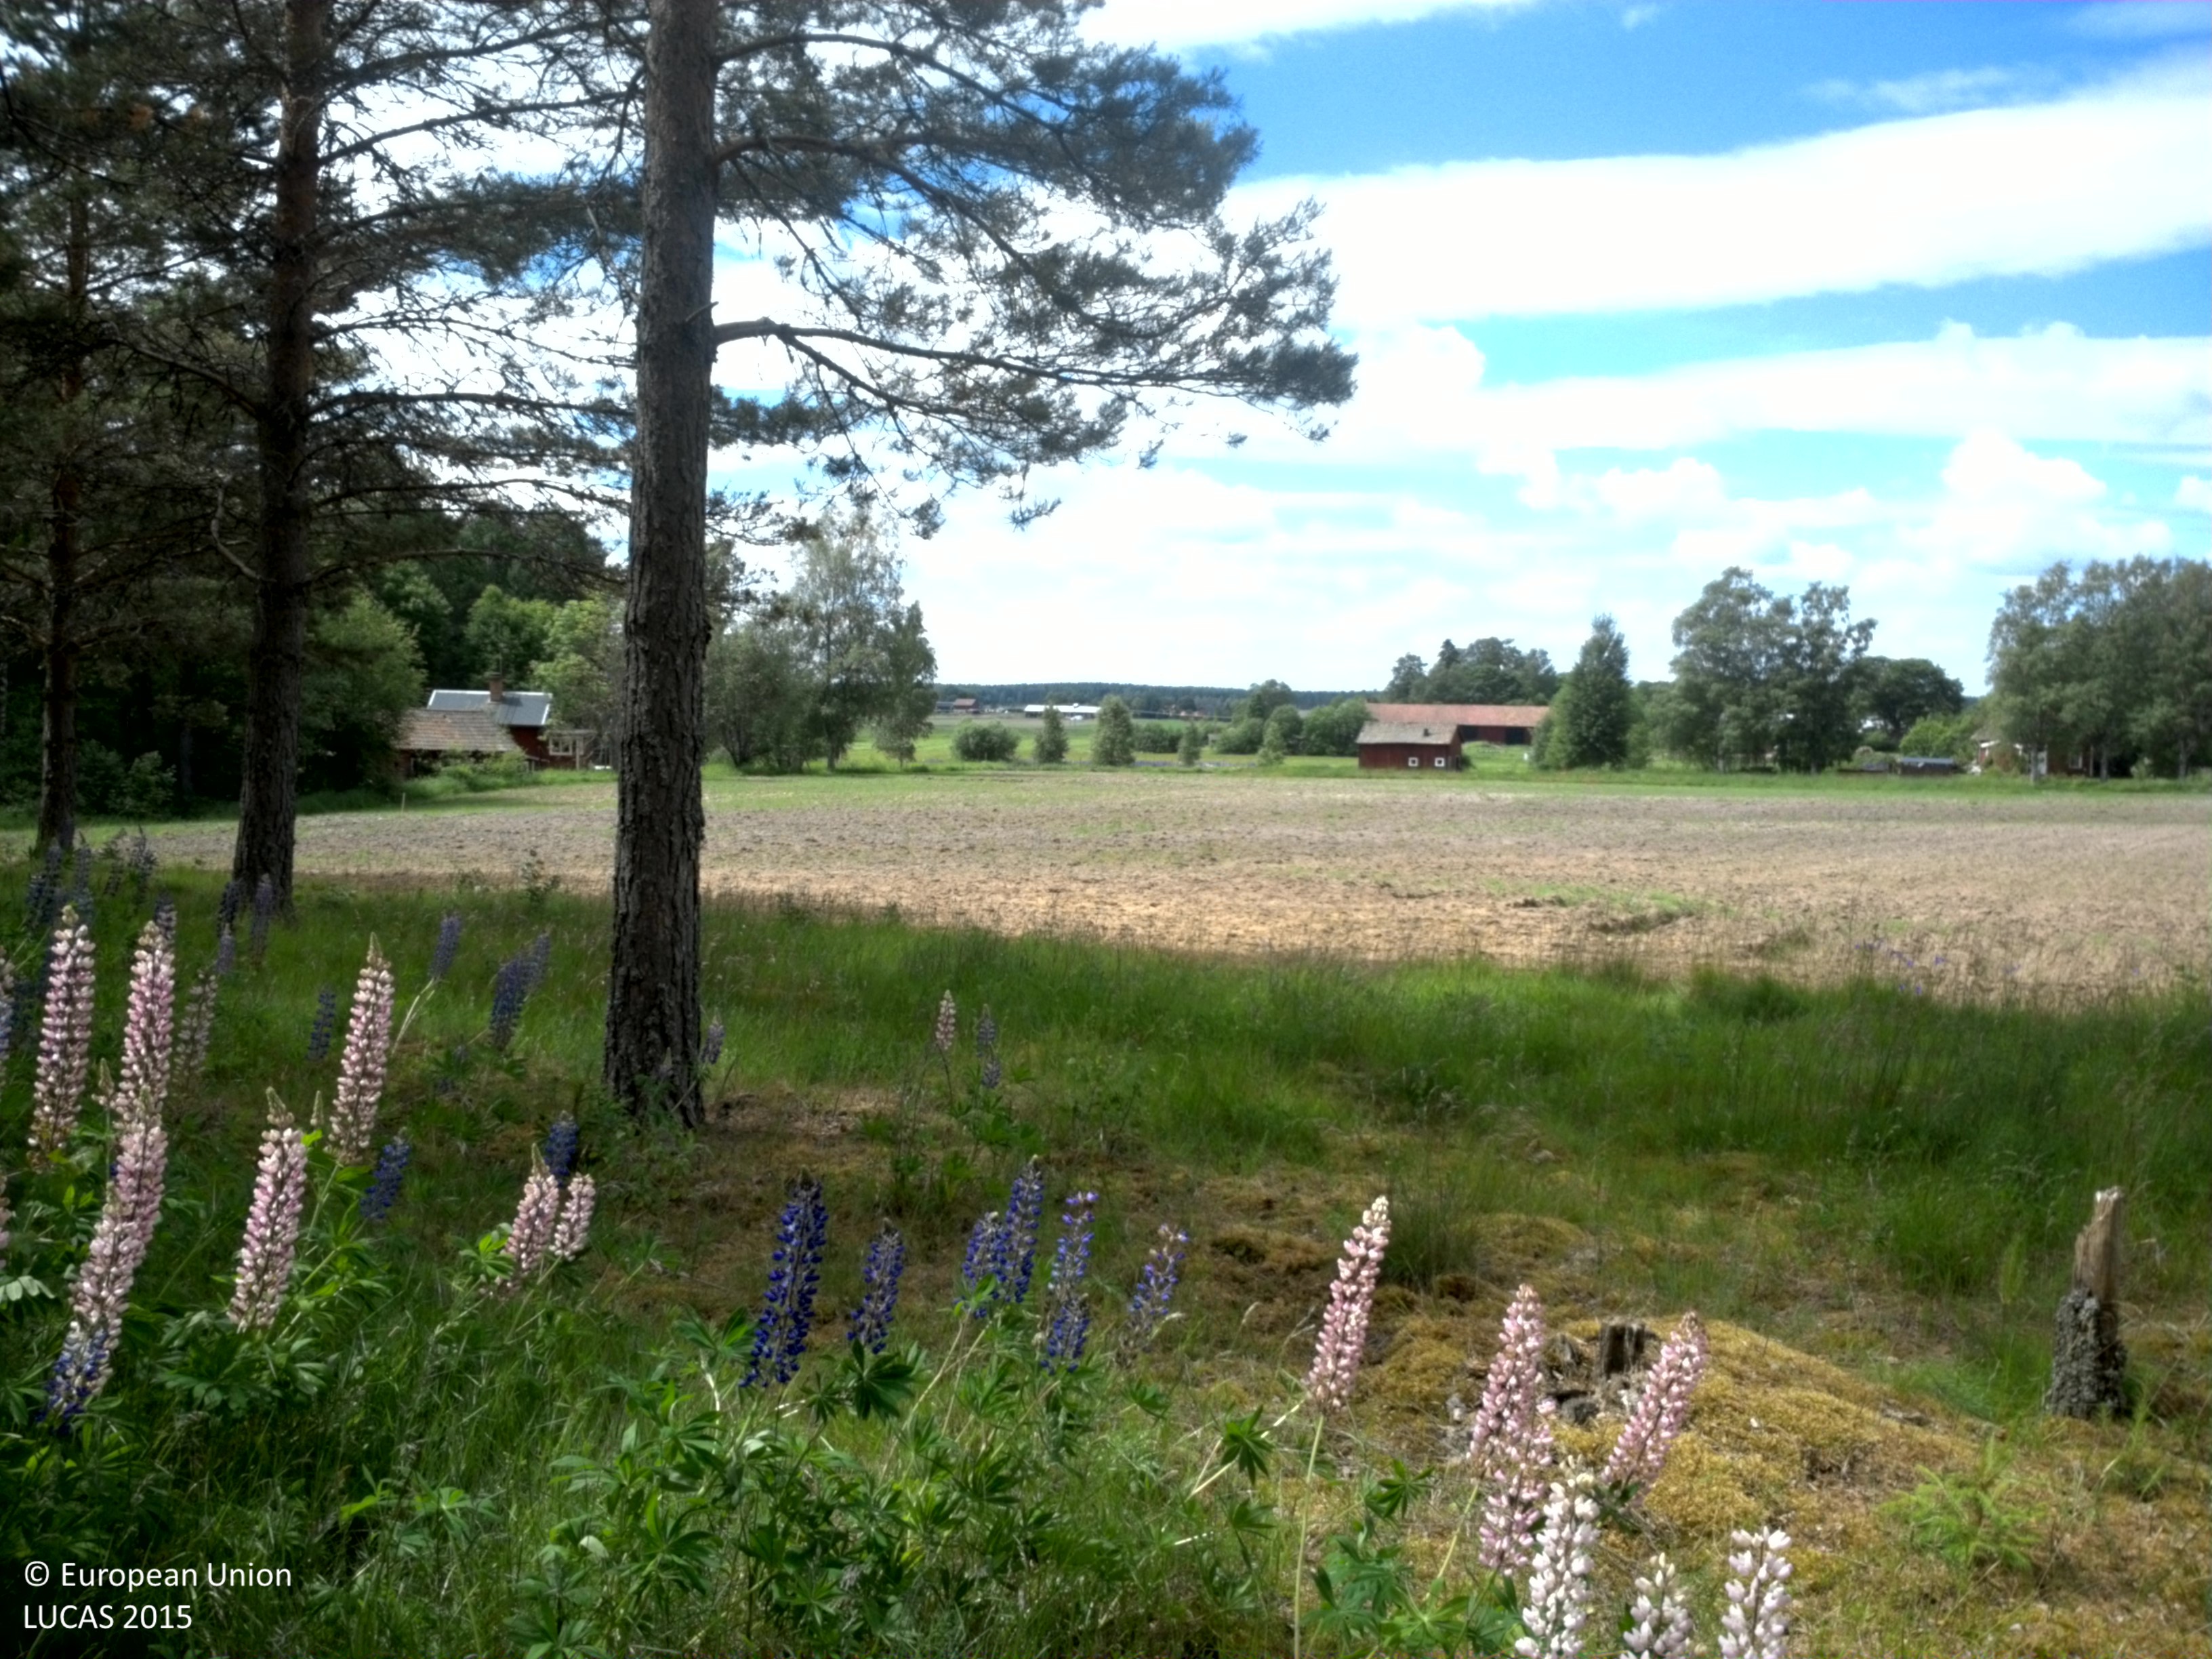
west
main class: Woodland
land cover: Pine dominated mixed woodland
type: boreal forest
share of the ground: 25 - 50 %
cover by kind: herbaceous plants 60 %, coniferous forest trees 25 %, broadleaved forest trees 15 %
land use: Forestry
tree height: > 5 m
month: July
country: SE
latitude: 60.0424
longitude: 17.0112
